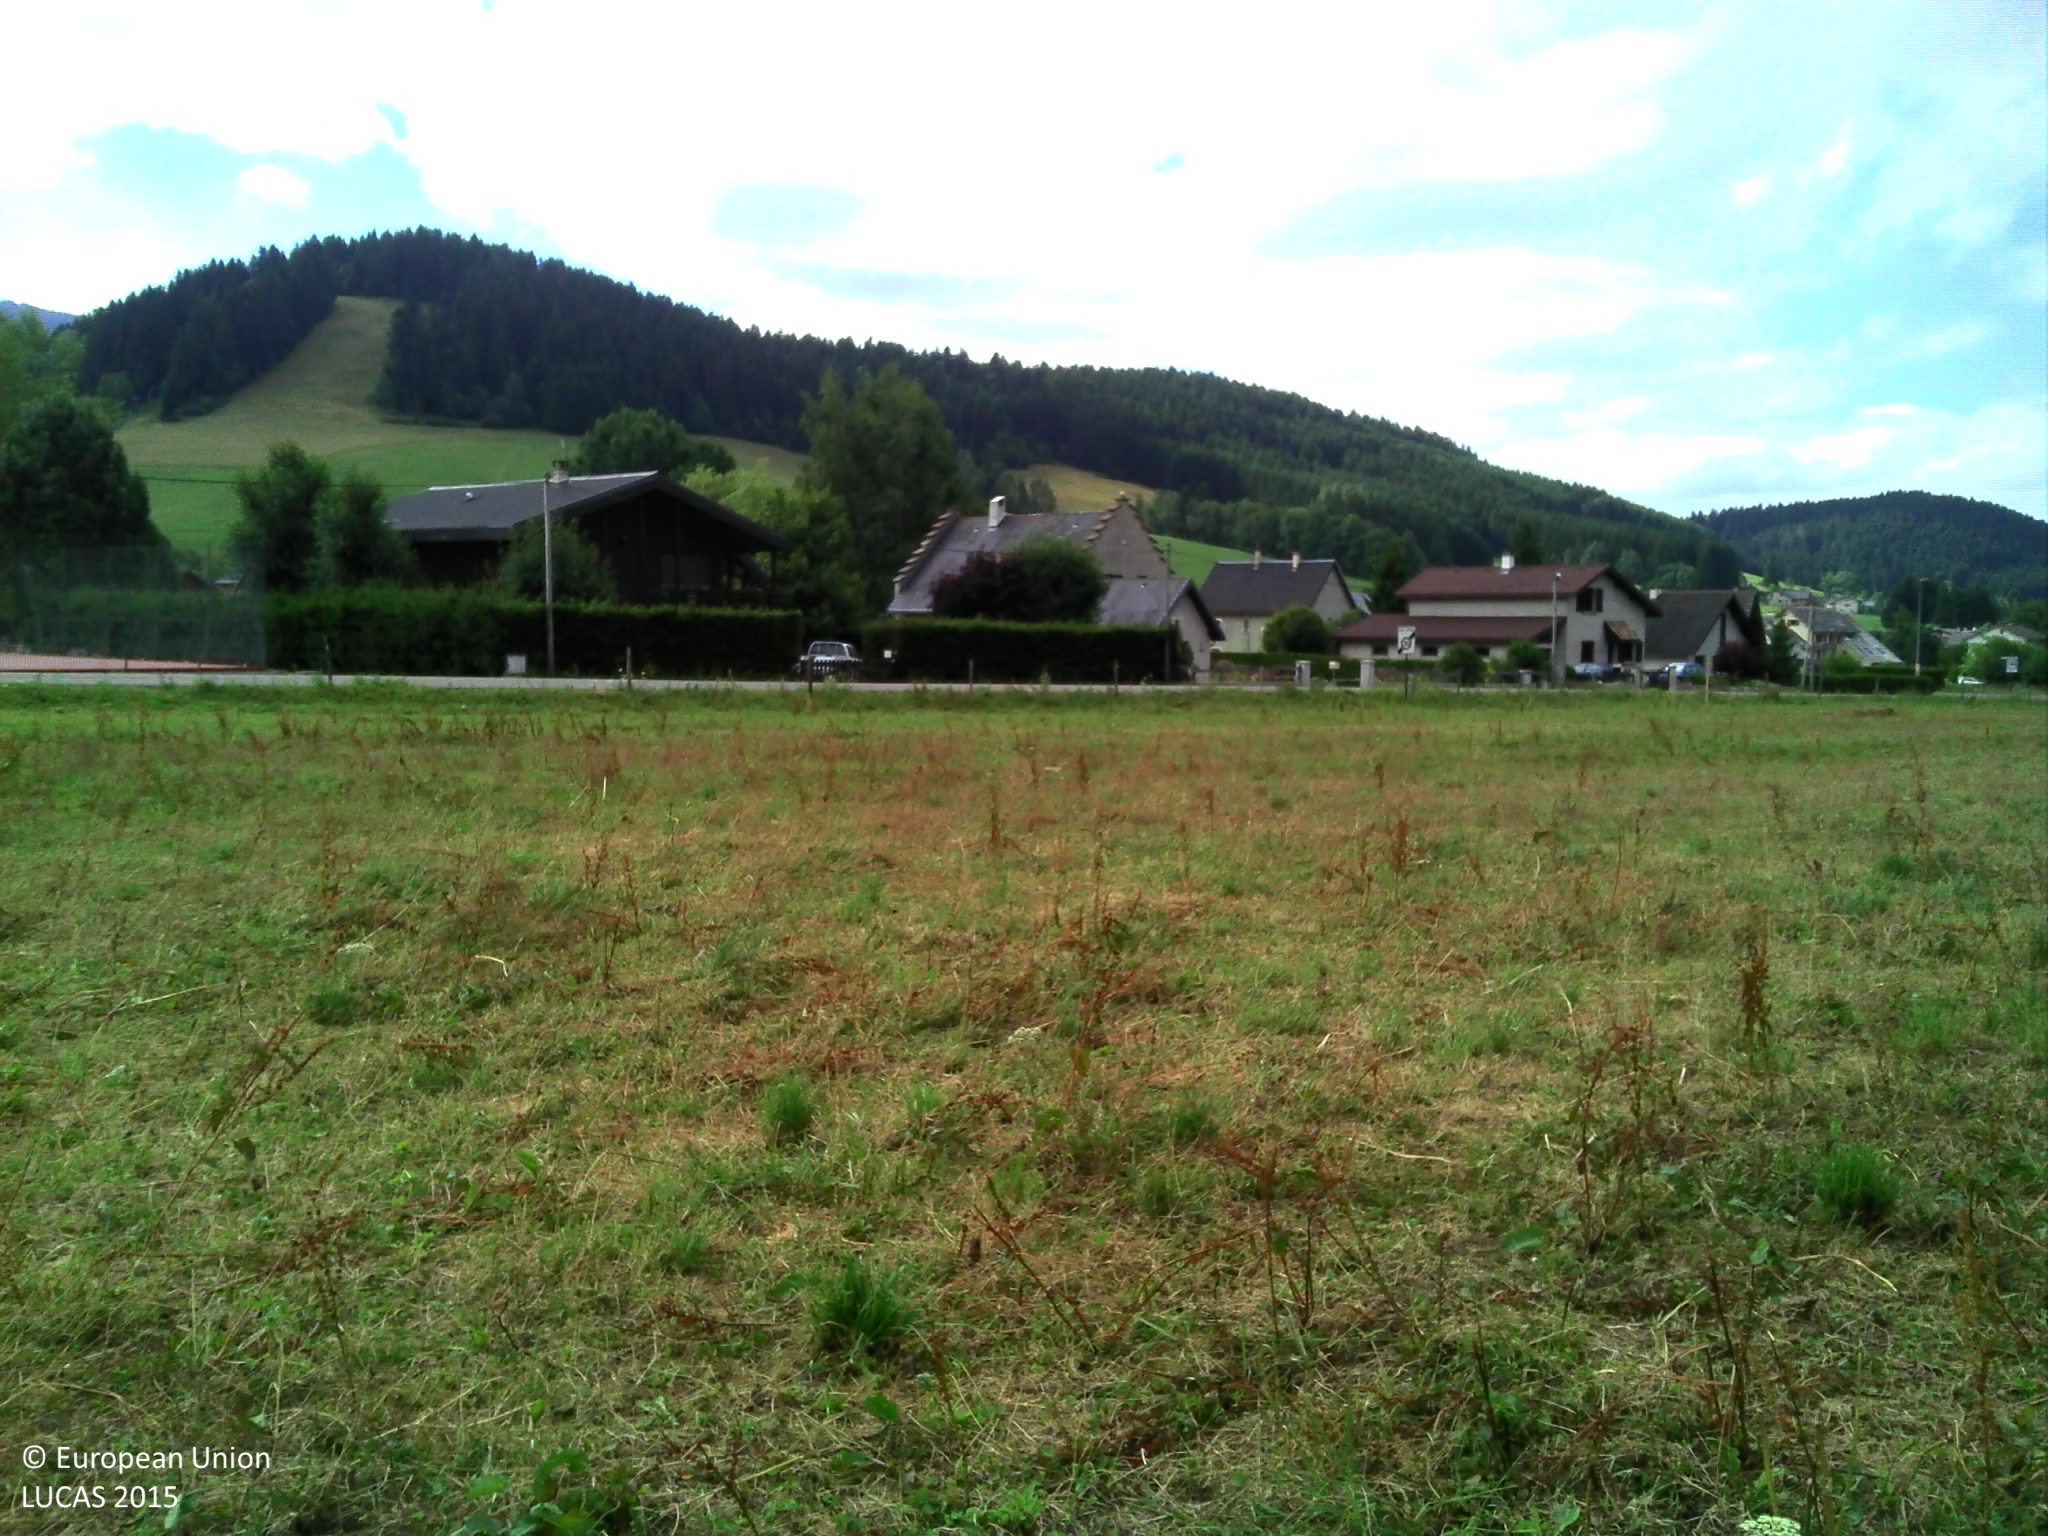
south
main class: Grassland
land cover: Grassland without tree/shrub cover
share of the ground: > 75 %
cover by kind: herbaceous plants 100 %
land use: Agriculture (excluding fallow land and kitchen gardens)
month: July
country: FR
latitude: 45.1755
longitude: 5.5390
